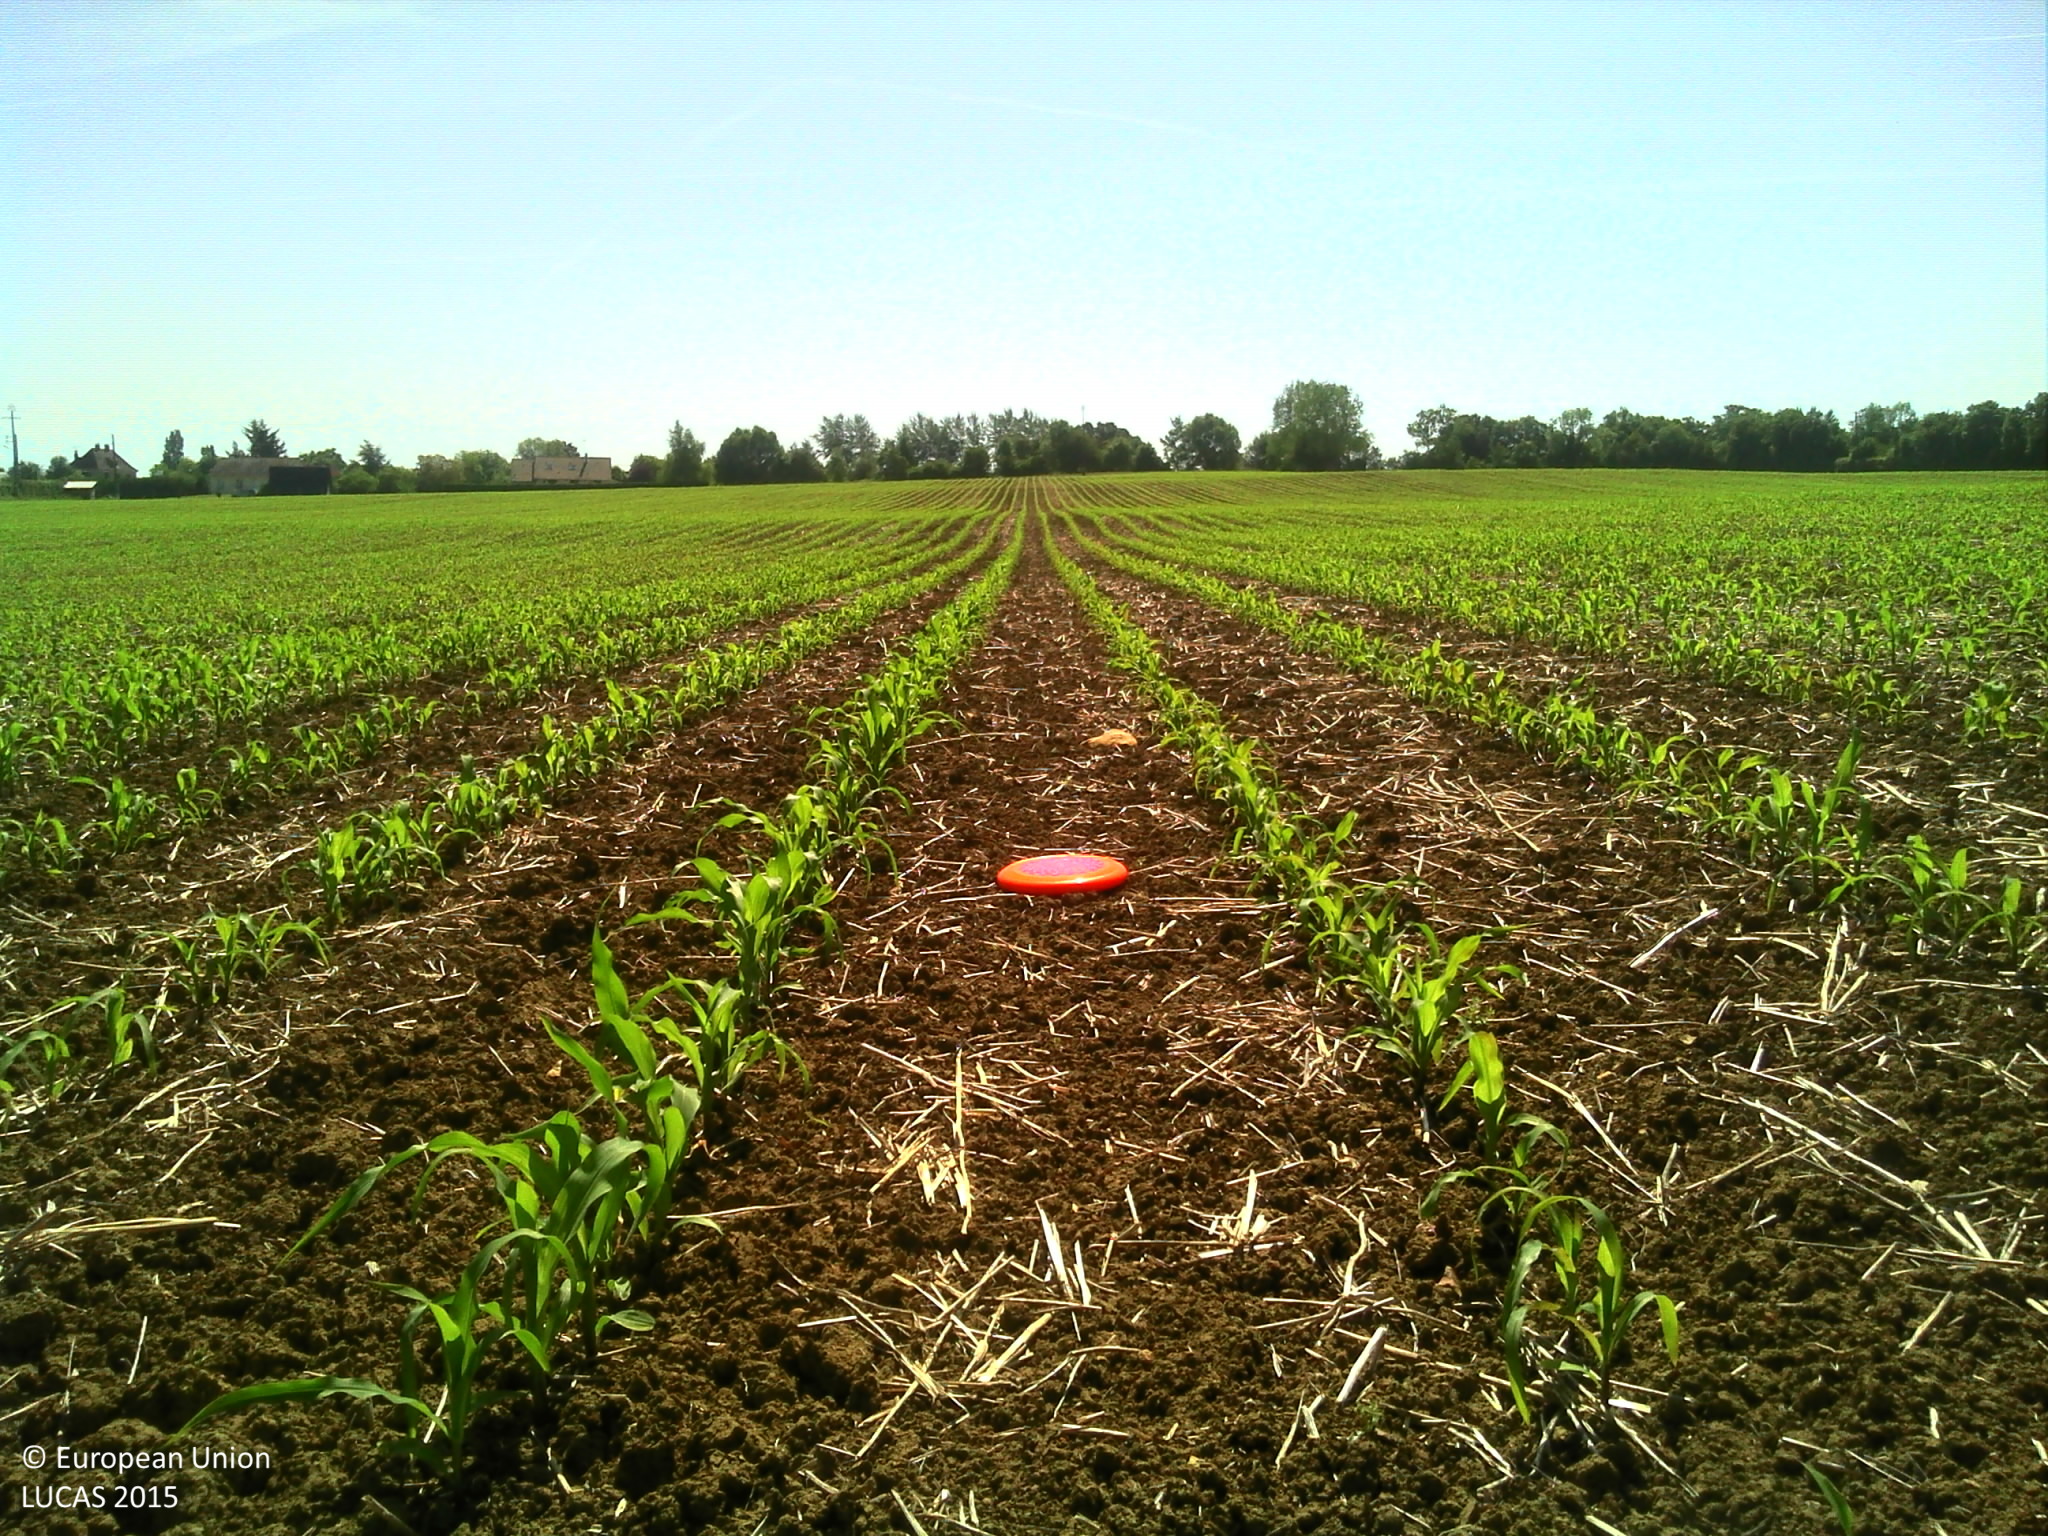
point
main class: Cropland
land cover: Maize
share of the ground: < 10 %
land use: Agriculture (excluding fallow land and kitchen gardens)
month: June
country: FR
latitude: 48.7743
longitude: 0.1055
